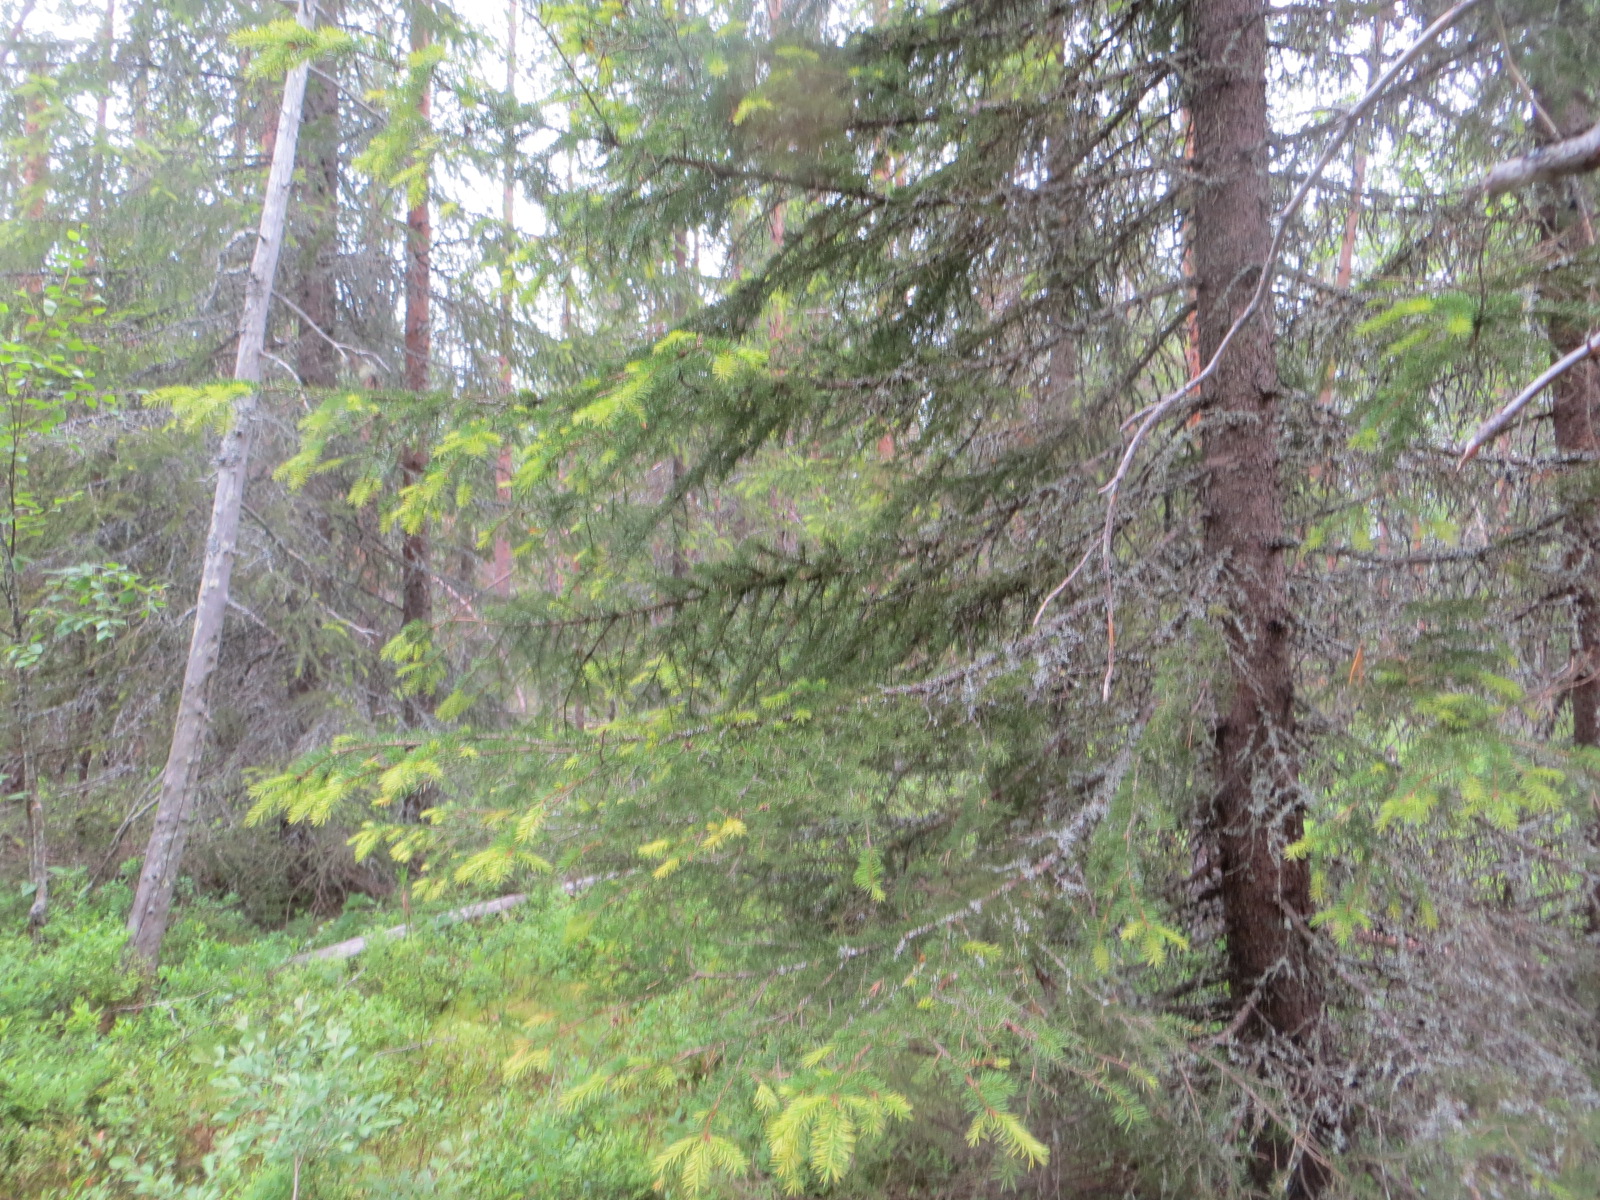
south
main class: Woodland
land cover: Other coniferous woodland
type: boreal forest
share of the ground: 50 - 75 %
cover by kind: coniferous forest trees 60 %, shrubs 30 %, broadleaved forest trees 10 %
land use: Forestry
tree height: > 5 m
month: July
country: FI
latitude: 65.7339
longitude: 25.3576
